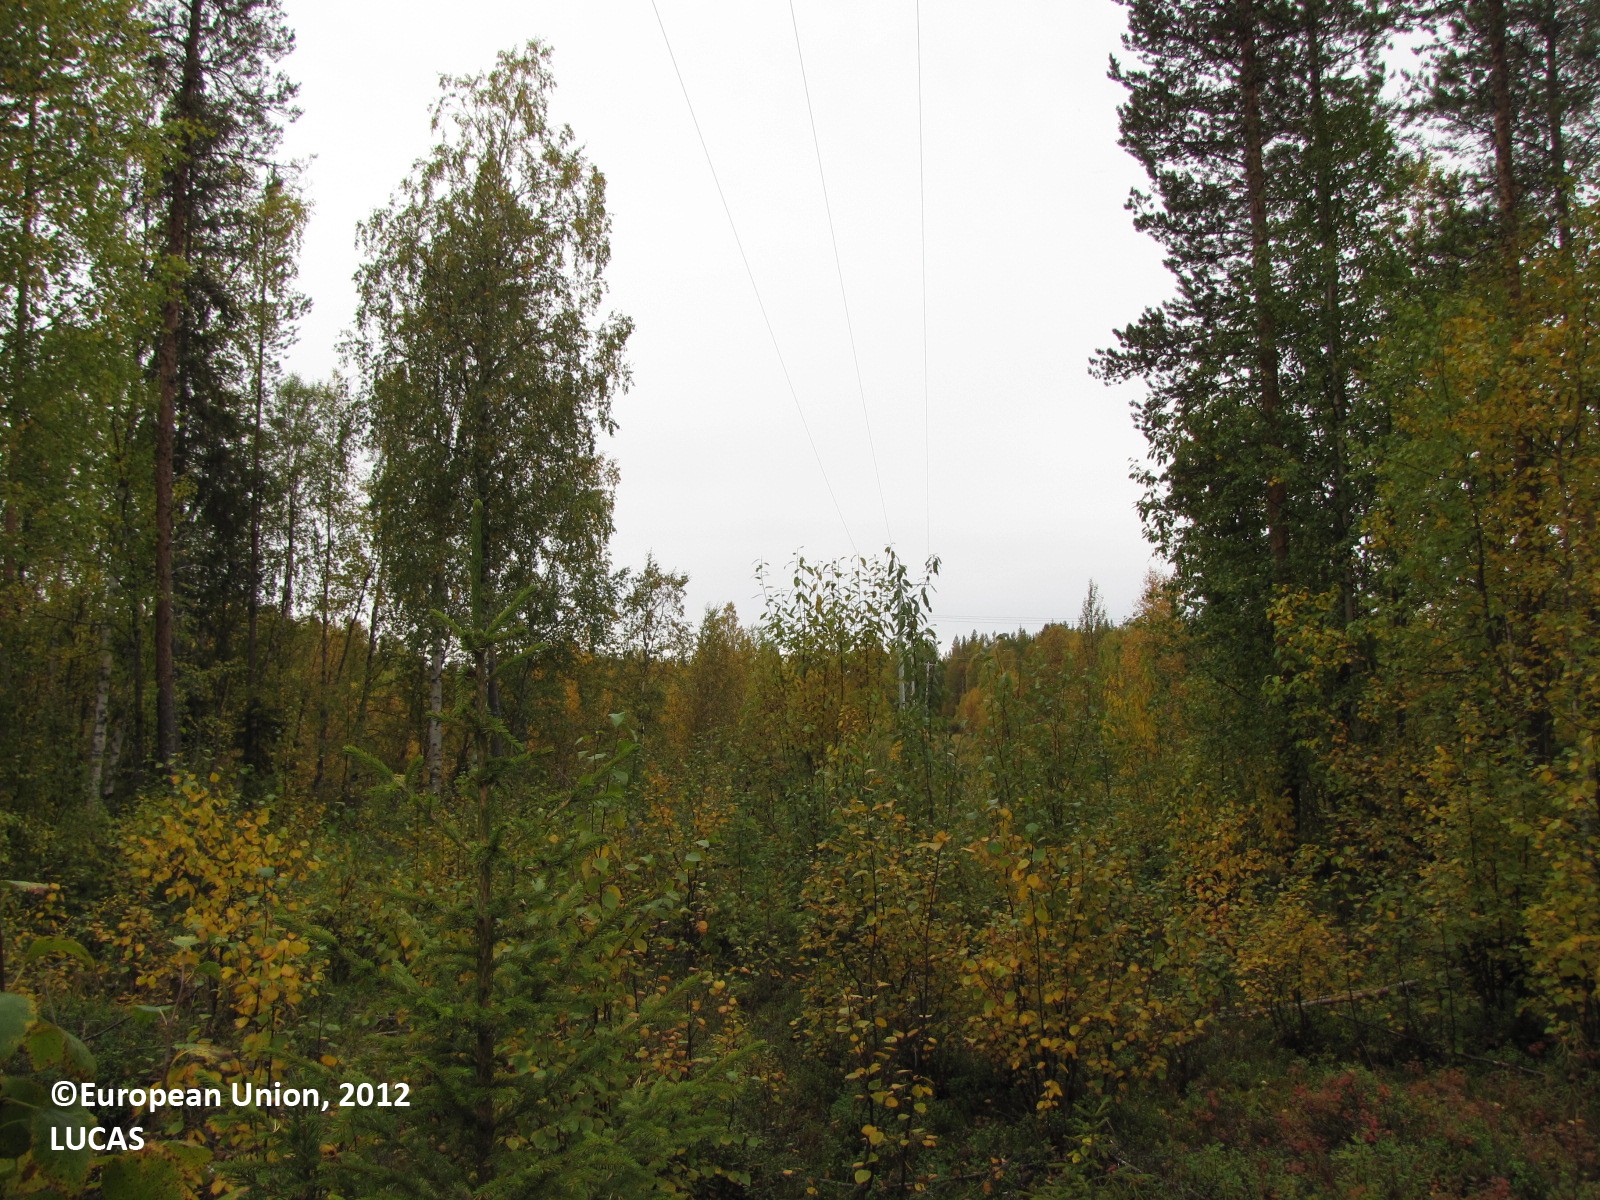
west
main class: Woodland
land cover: Broadleaved woodland
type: boreal forest
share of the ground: 25 - 50 %
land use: Energy production
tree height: < 5 m
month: September
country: FI
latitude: 67.1947
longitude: 25.1909
